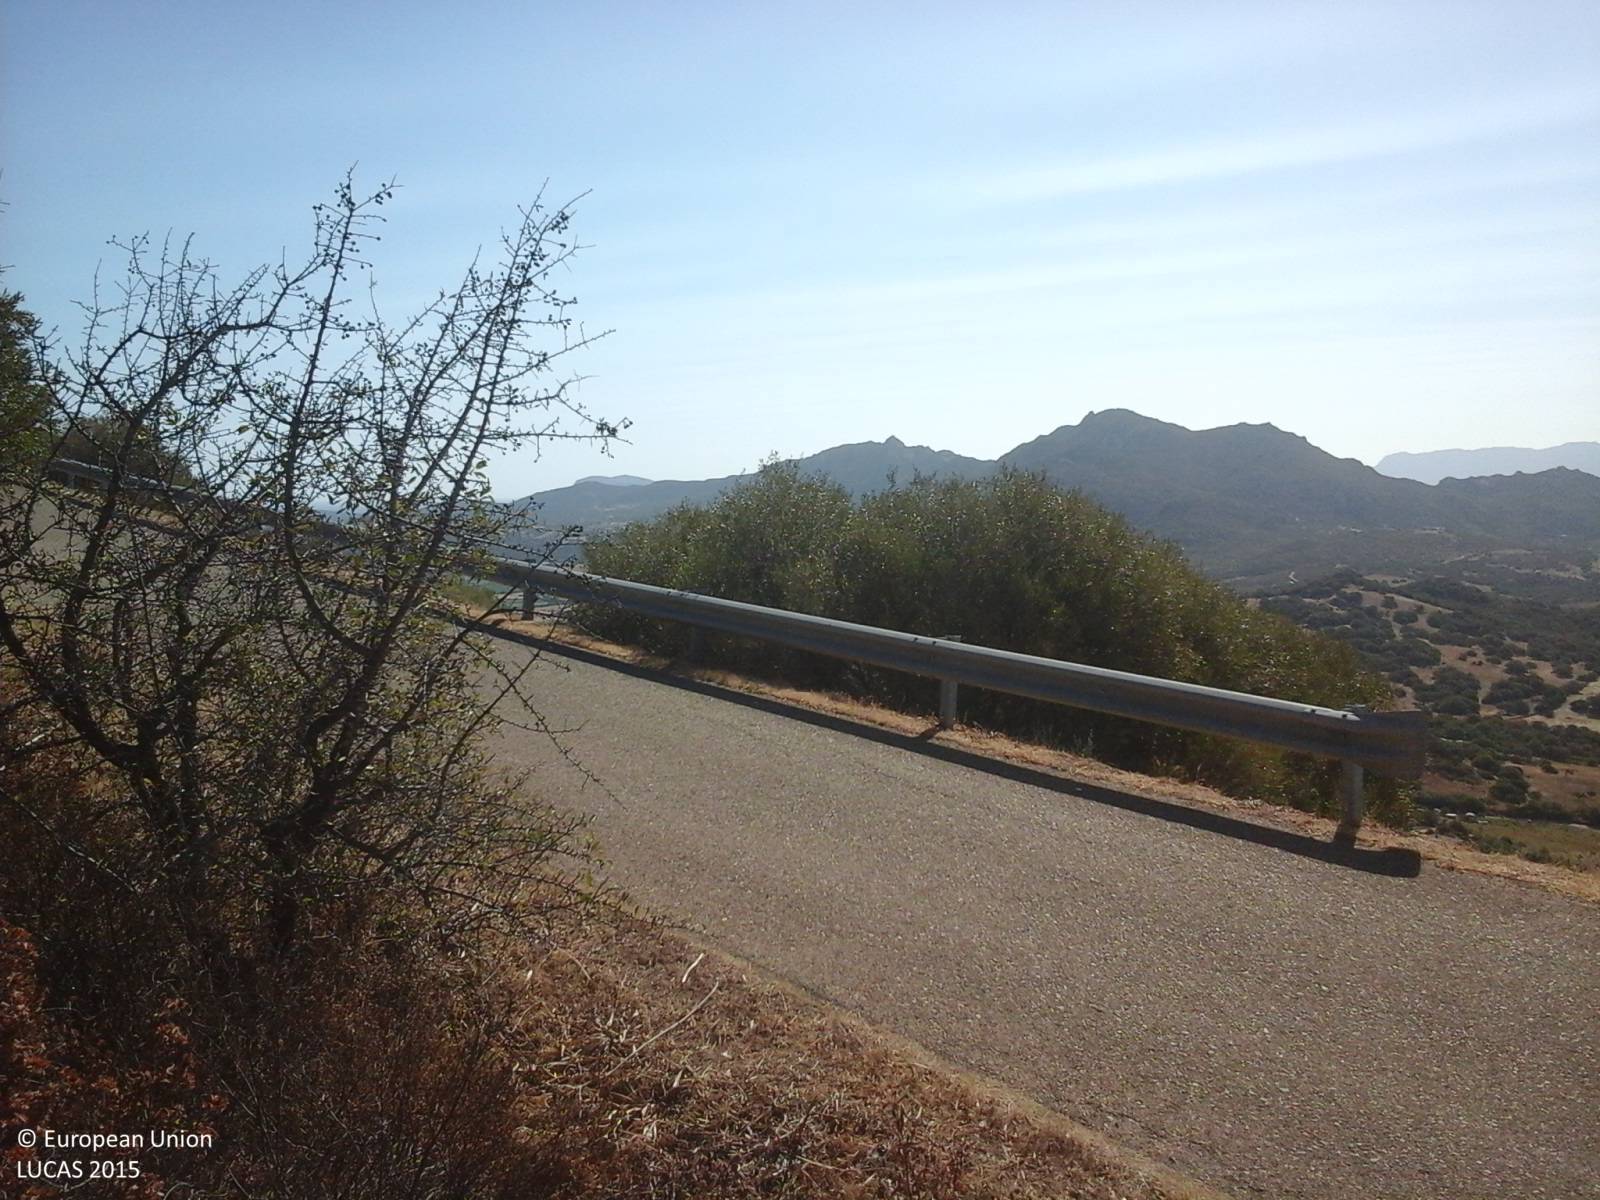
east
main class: Shrubland
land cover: Shrubland with sparse tree cover
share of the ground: > 75 %
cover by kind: shrubs 90 %, broadleaved forest trees 5 %, unconsolidated bare surface 5 %
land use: Semi-natural and natural areas not in use
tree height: > 5 m
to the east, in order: Shrubland with sparse tree cover; Grass margins; Paved roads, cycling and walking lanes; Grass margins; Shrubland with sparse tree cover; Grass margins; Paved roads, cycling and walking lanes; Grass margins; Shrubland with sparse tree cover
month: August
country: IT
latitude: 40.9716
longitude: 9.4677
